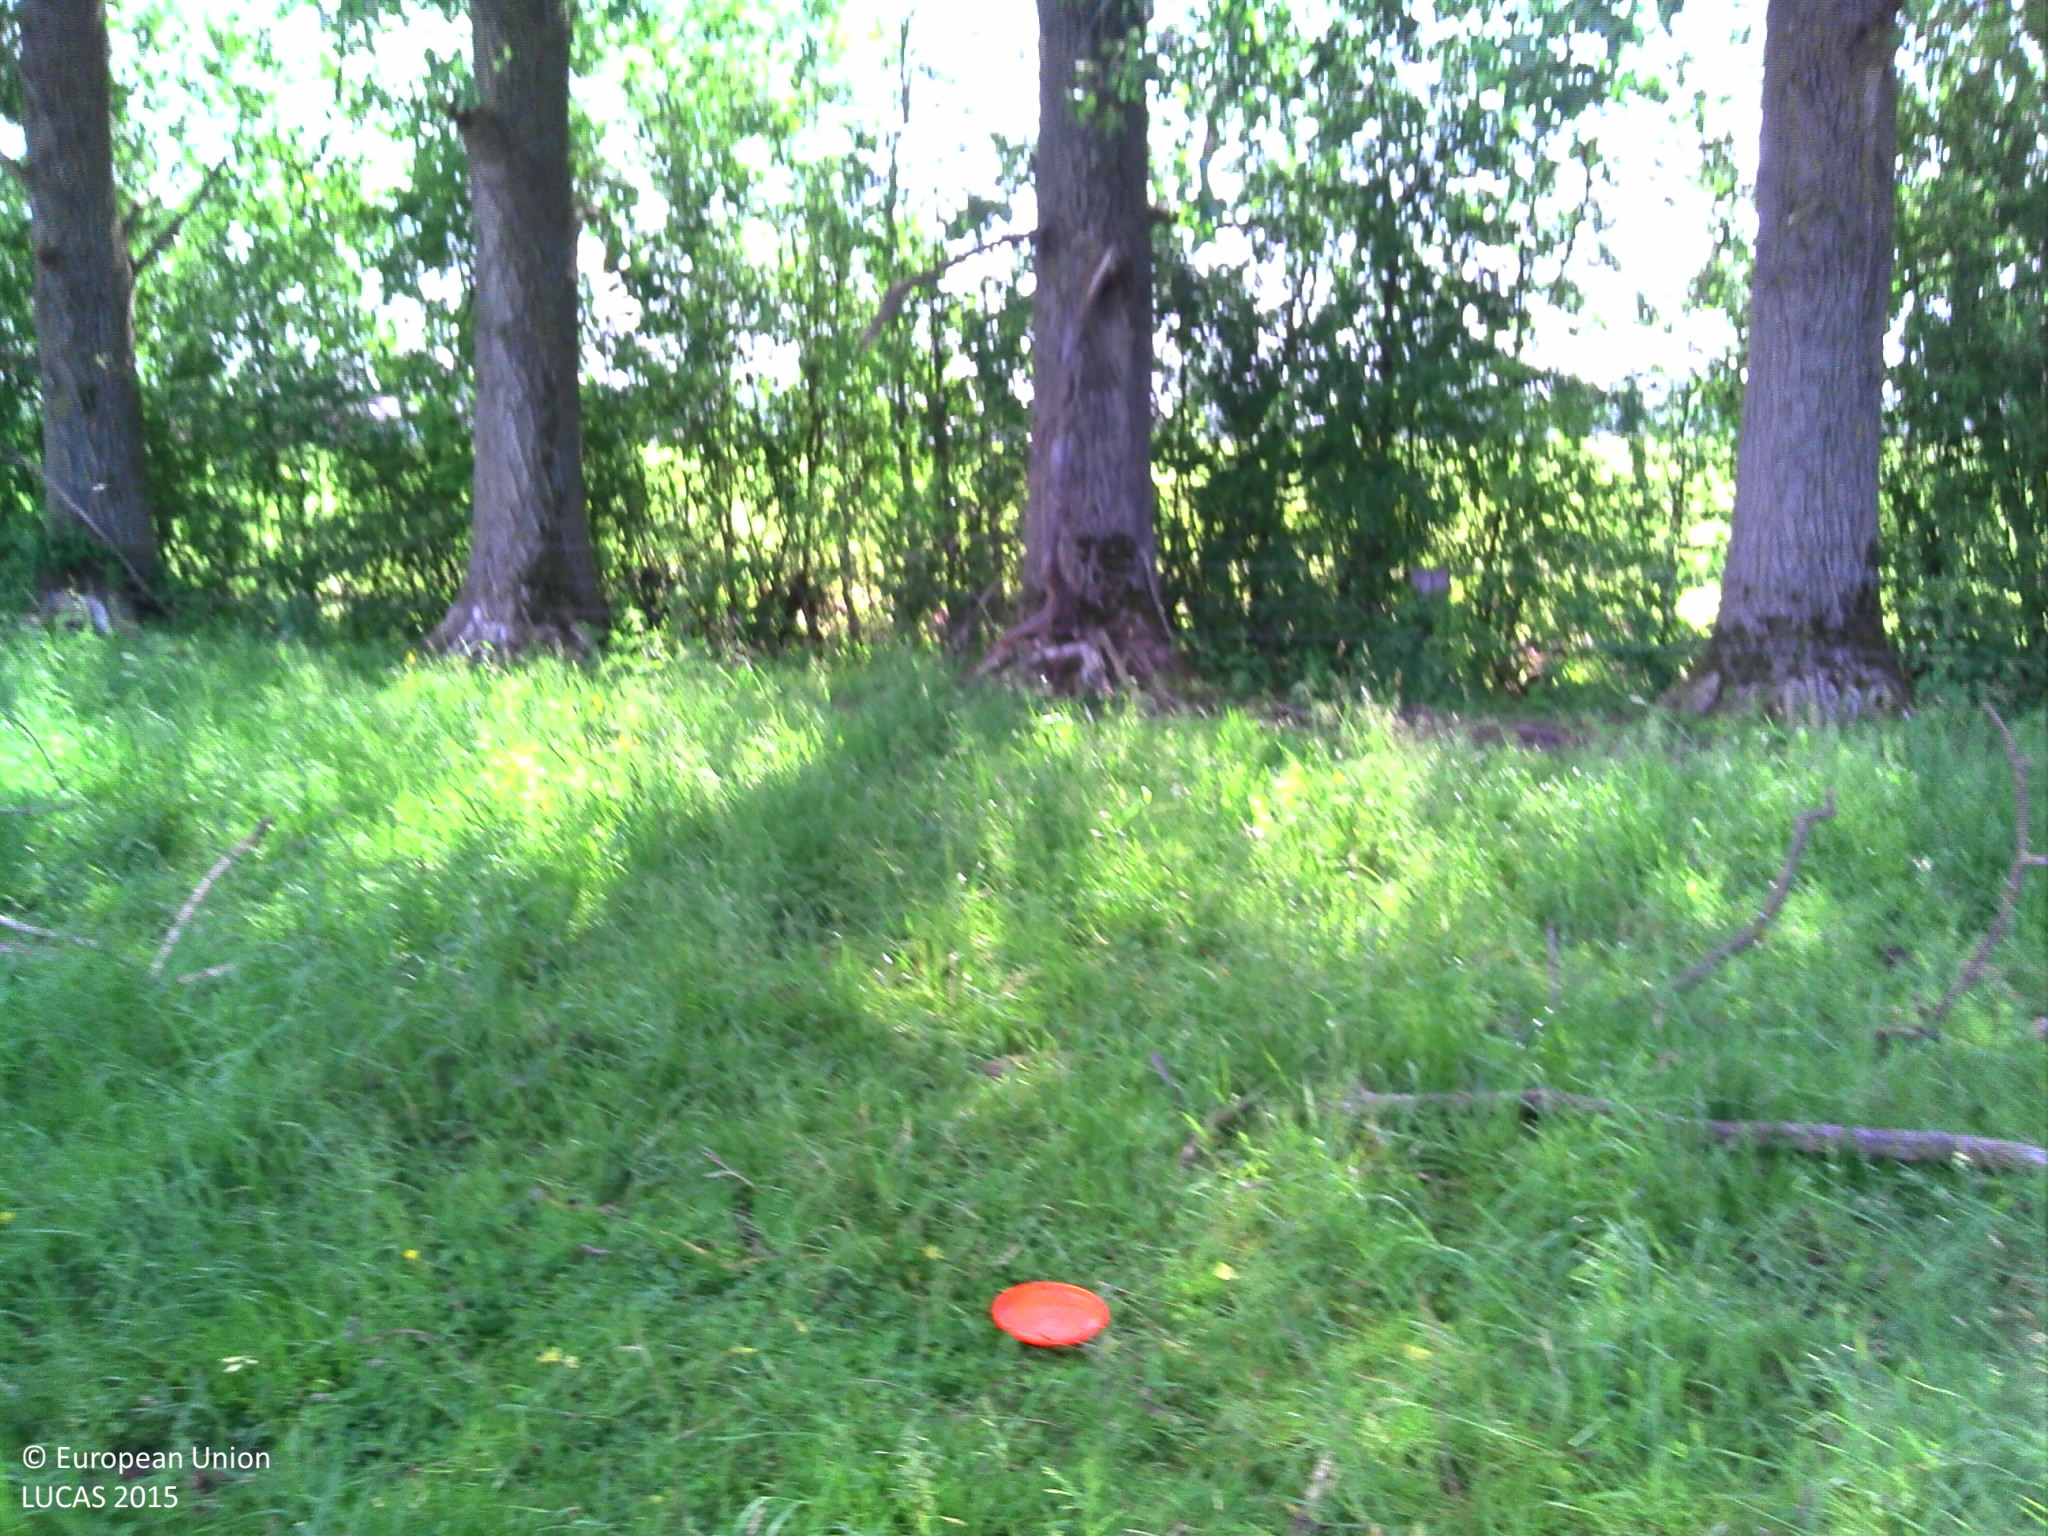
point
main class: Grassland
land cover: Grassland without tree/shrub cover
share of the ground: > 75 %
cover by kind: herbaceous plants 100 %
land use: Agriculture (excluding fallow land and kitchen gardens)
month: June
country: BE
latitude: 50.9236
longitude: 3.9192
